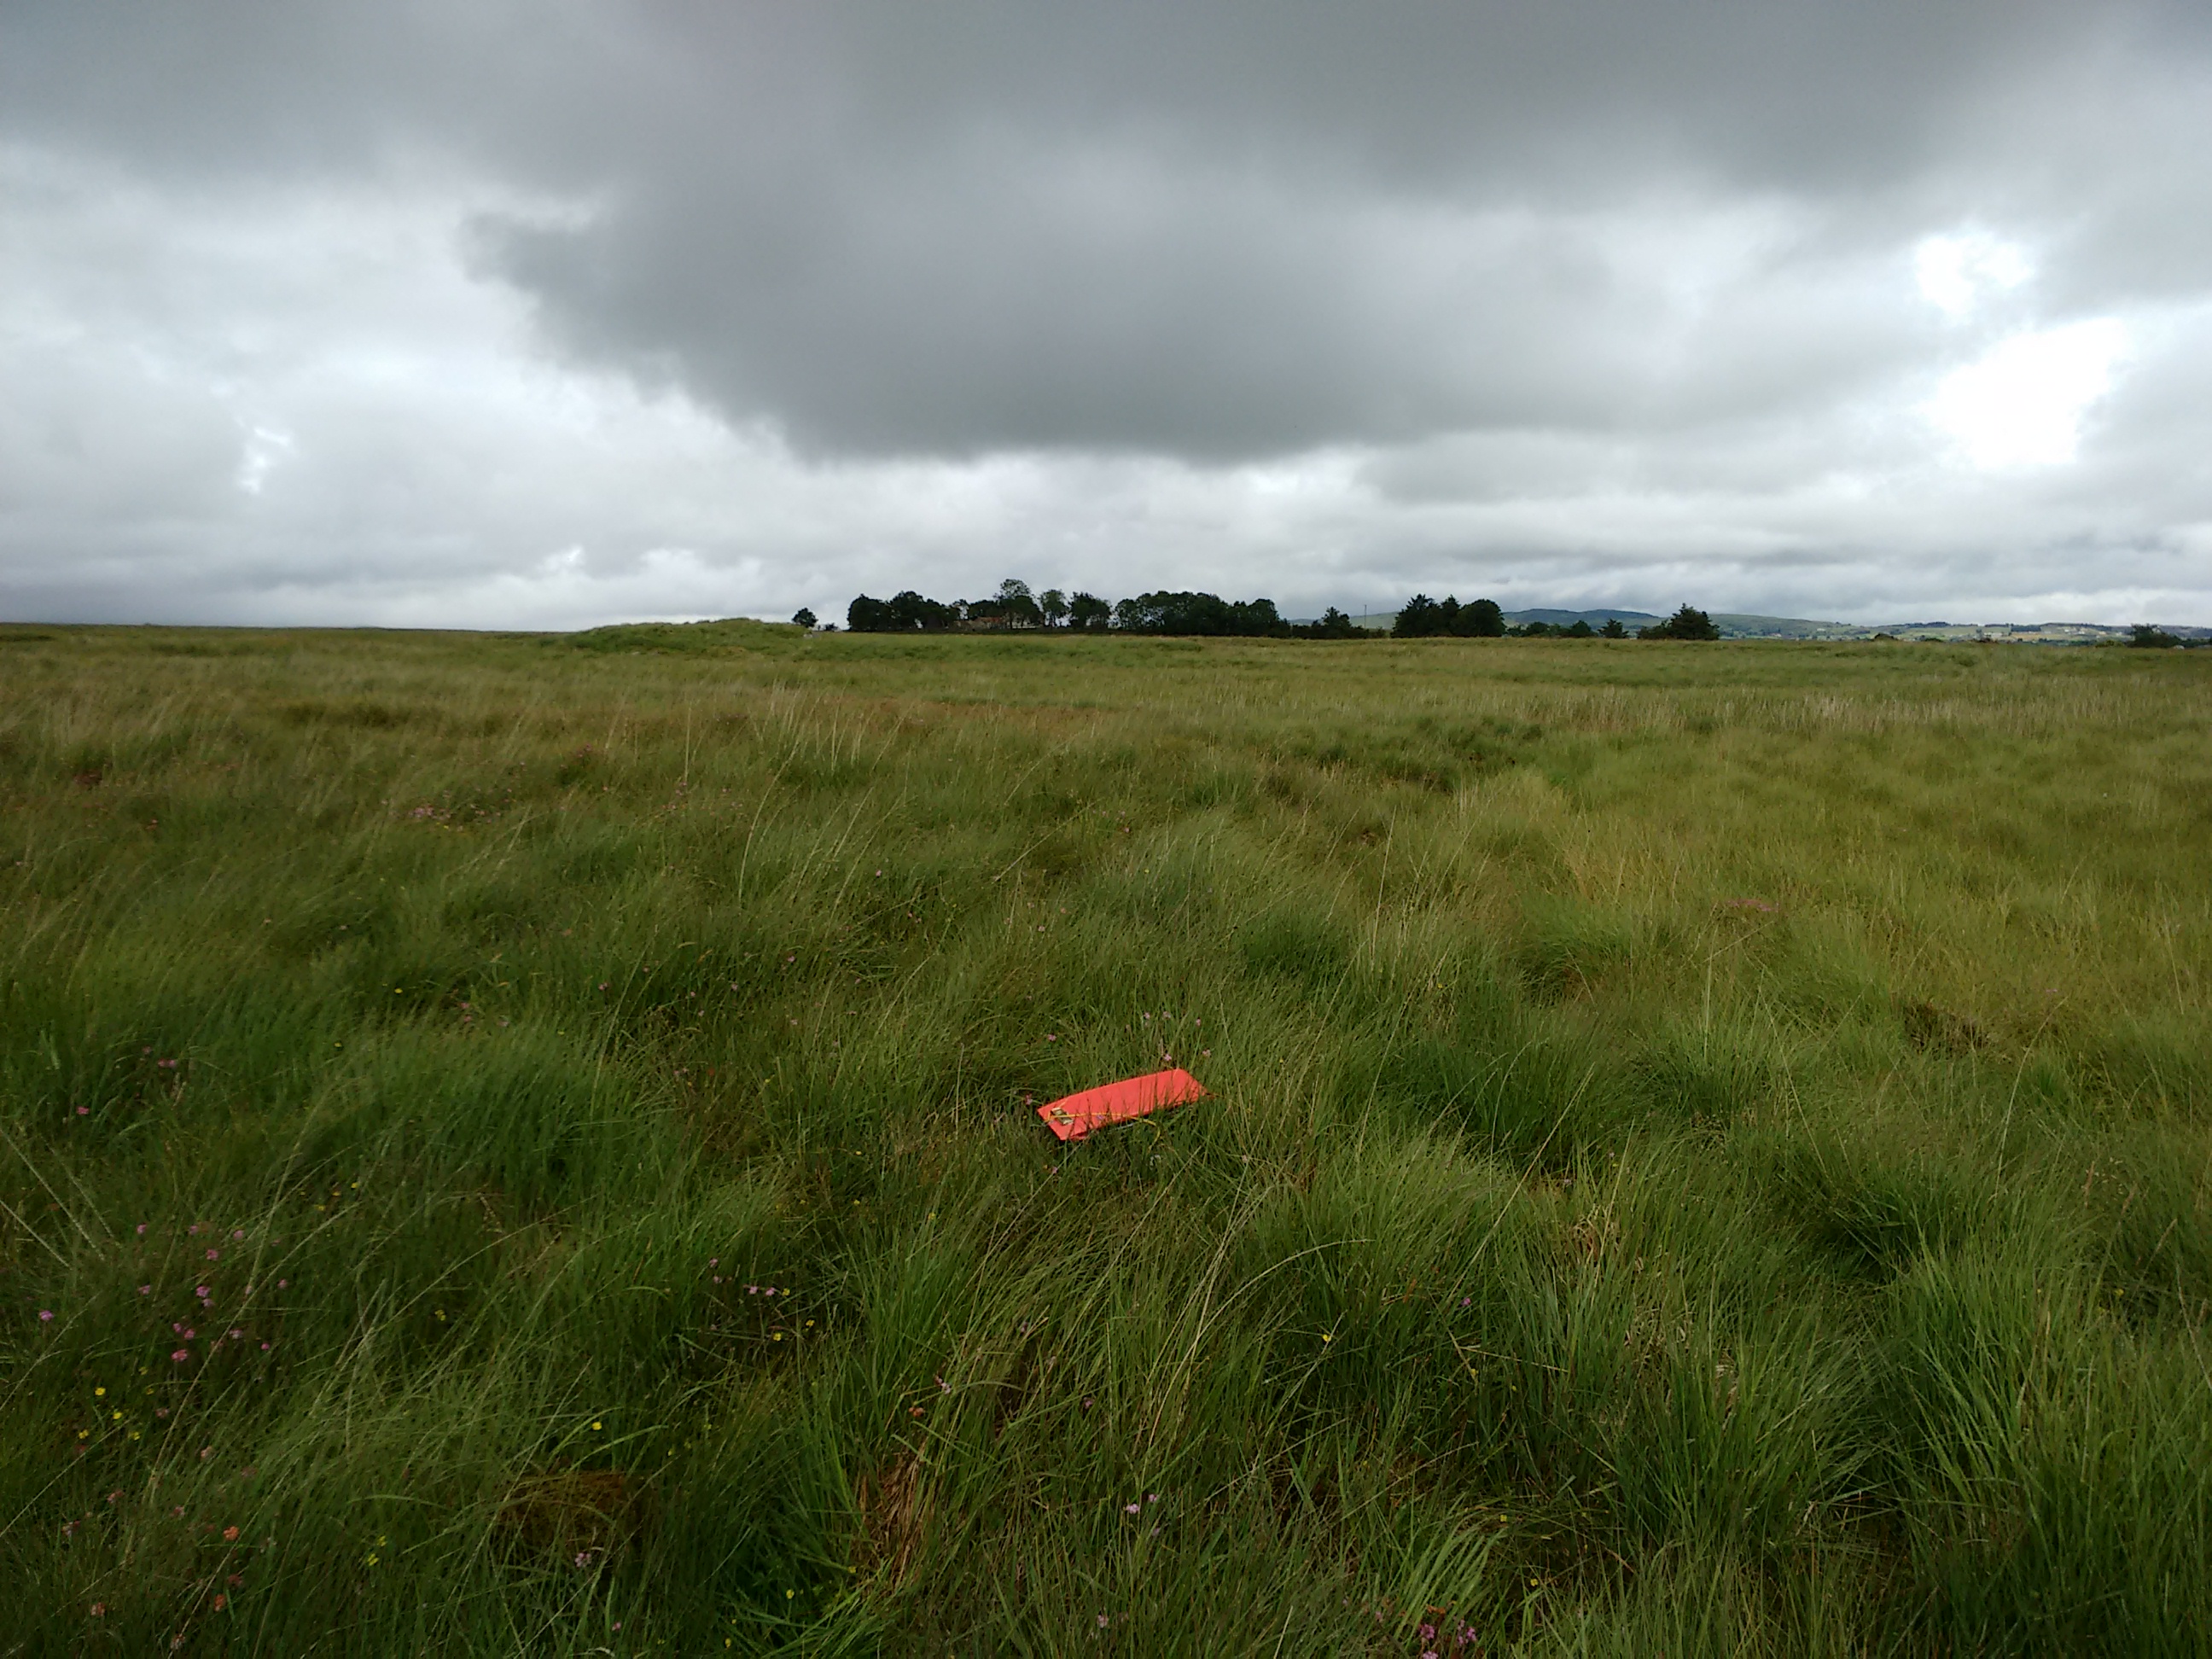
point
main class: Grassland
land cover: Grassland without tree/shrub cover
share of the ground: > 75 %
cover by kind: herbaceous plants 100 %
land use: Agriculture (excluding fallow land and kitchen gardens)
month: July
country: GB
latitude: 54.6553
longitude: -6.9875
